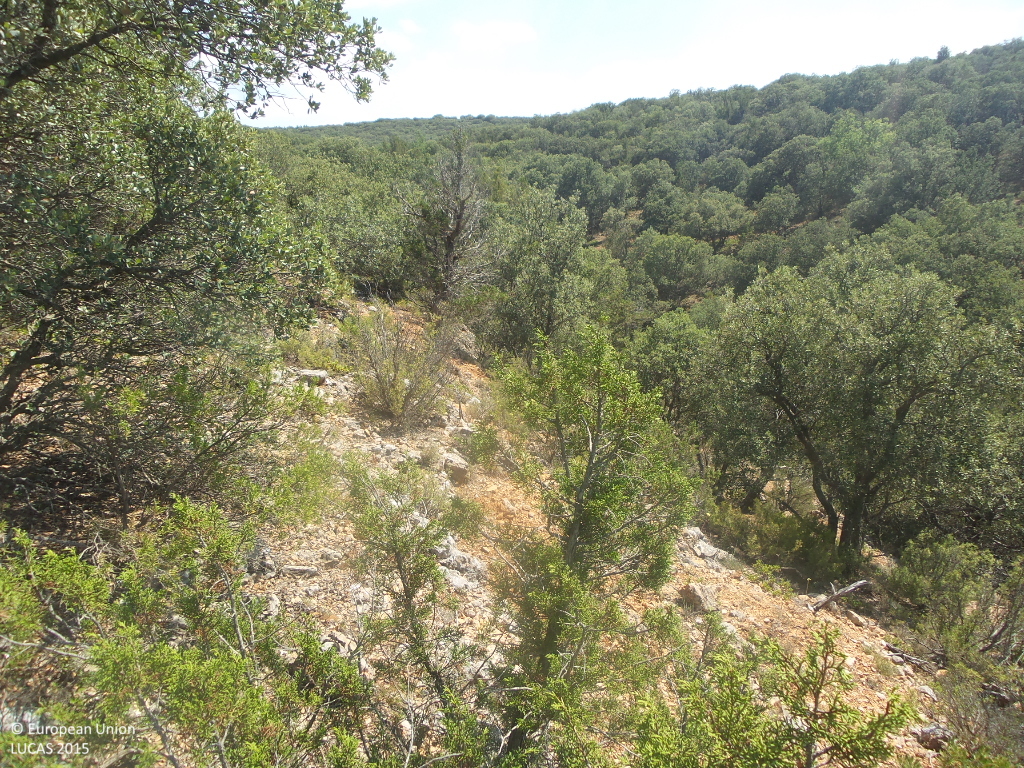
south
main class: Woodland
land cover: Broadleaved woodland
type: broadleaved evergreen forest
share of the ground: > 75 %
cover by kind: broadleaved forest trees 80 %, unconsolidated bare surface 10 %, shrubs 5 %, herbaceous plants 5 %
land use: Semi-natural and natural areas not in use
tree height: > 5 m
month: July
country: ES
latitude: 41.1536
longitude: -2.1468
